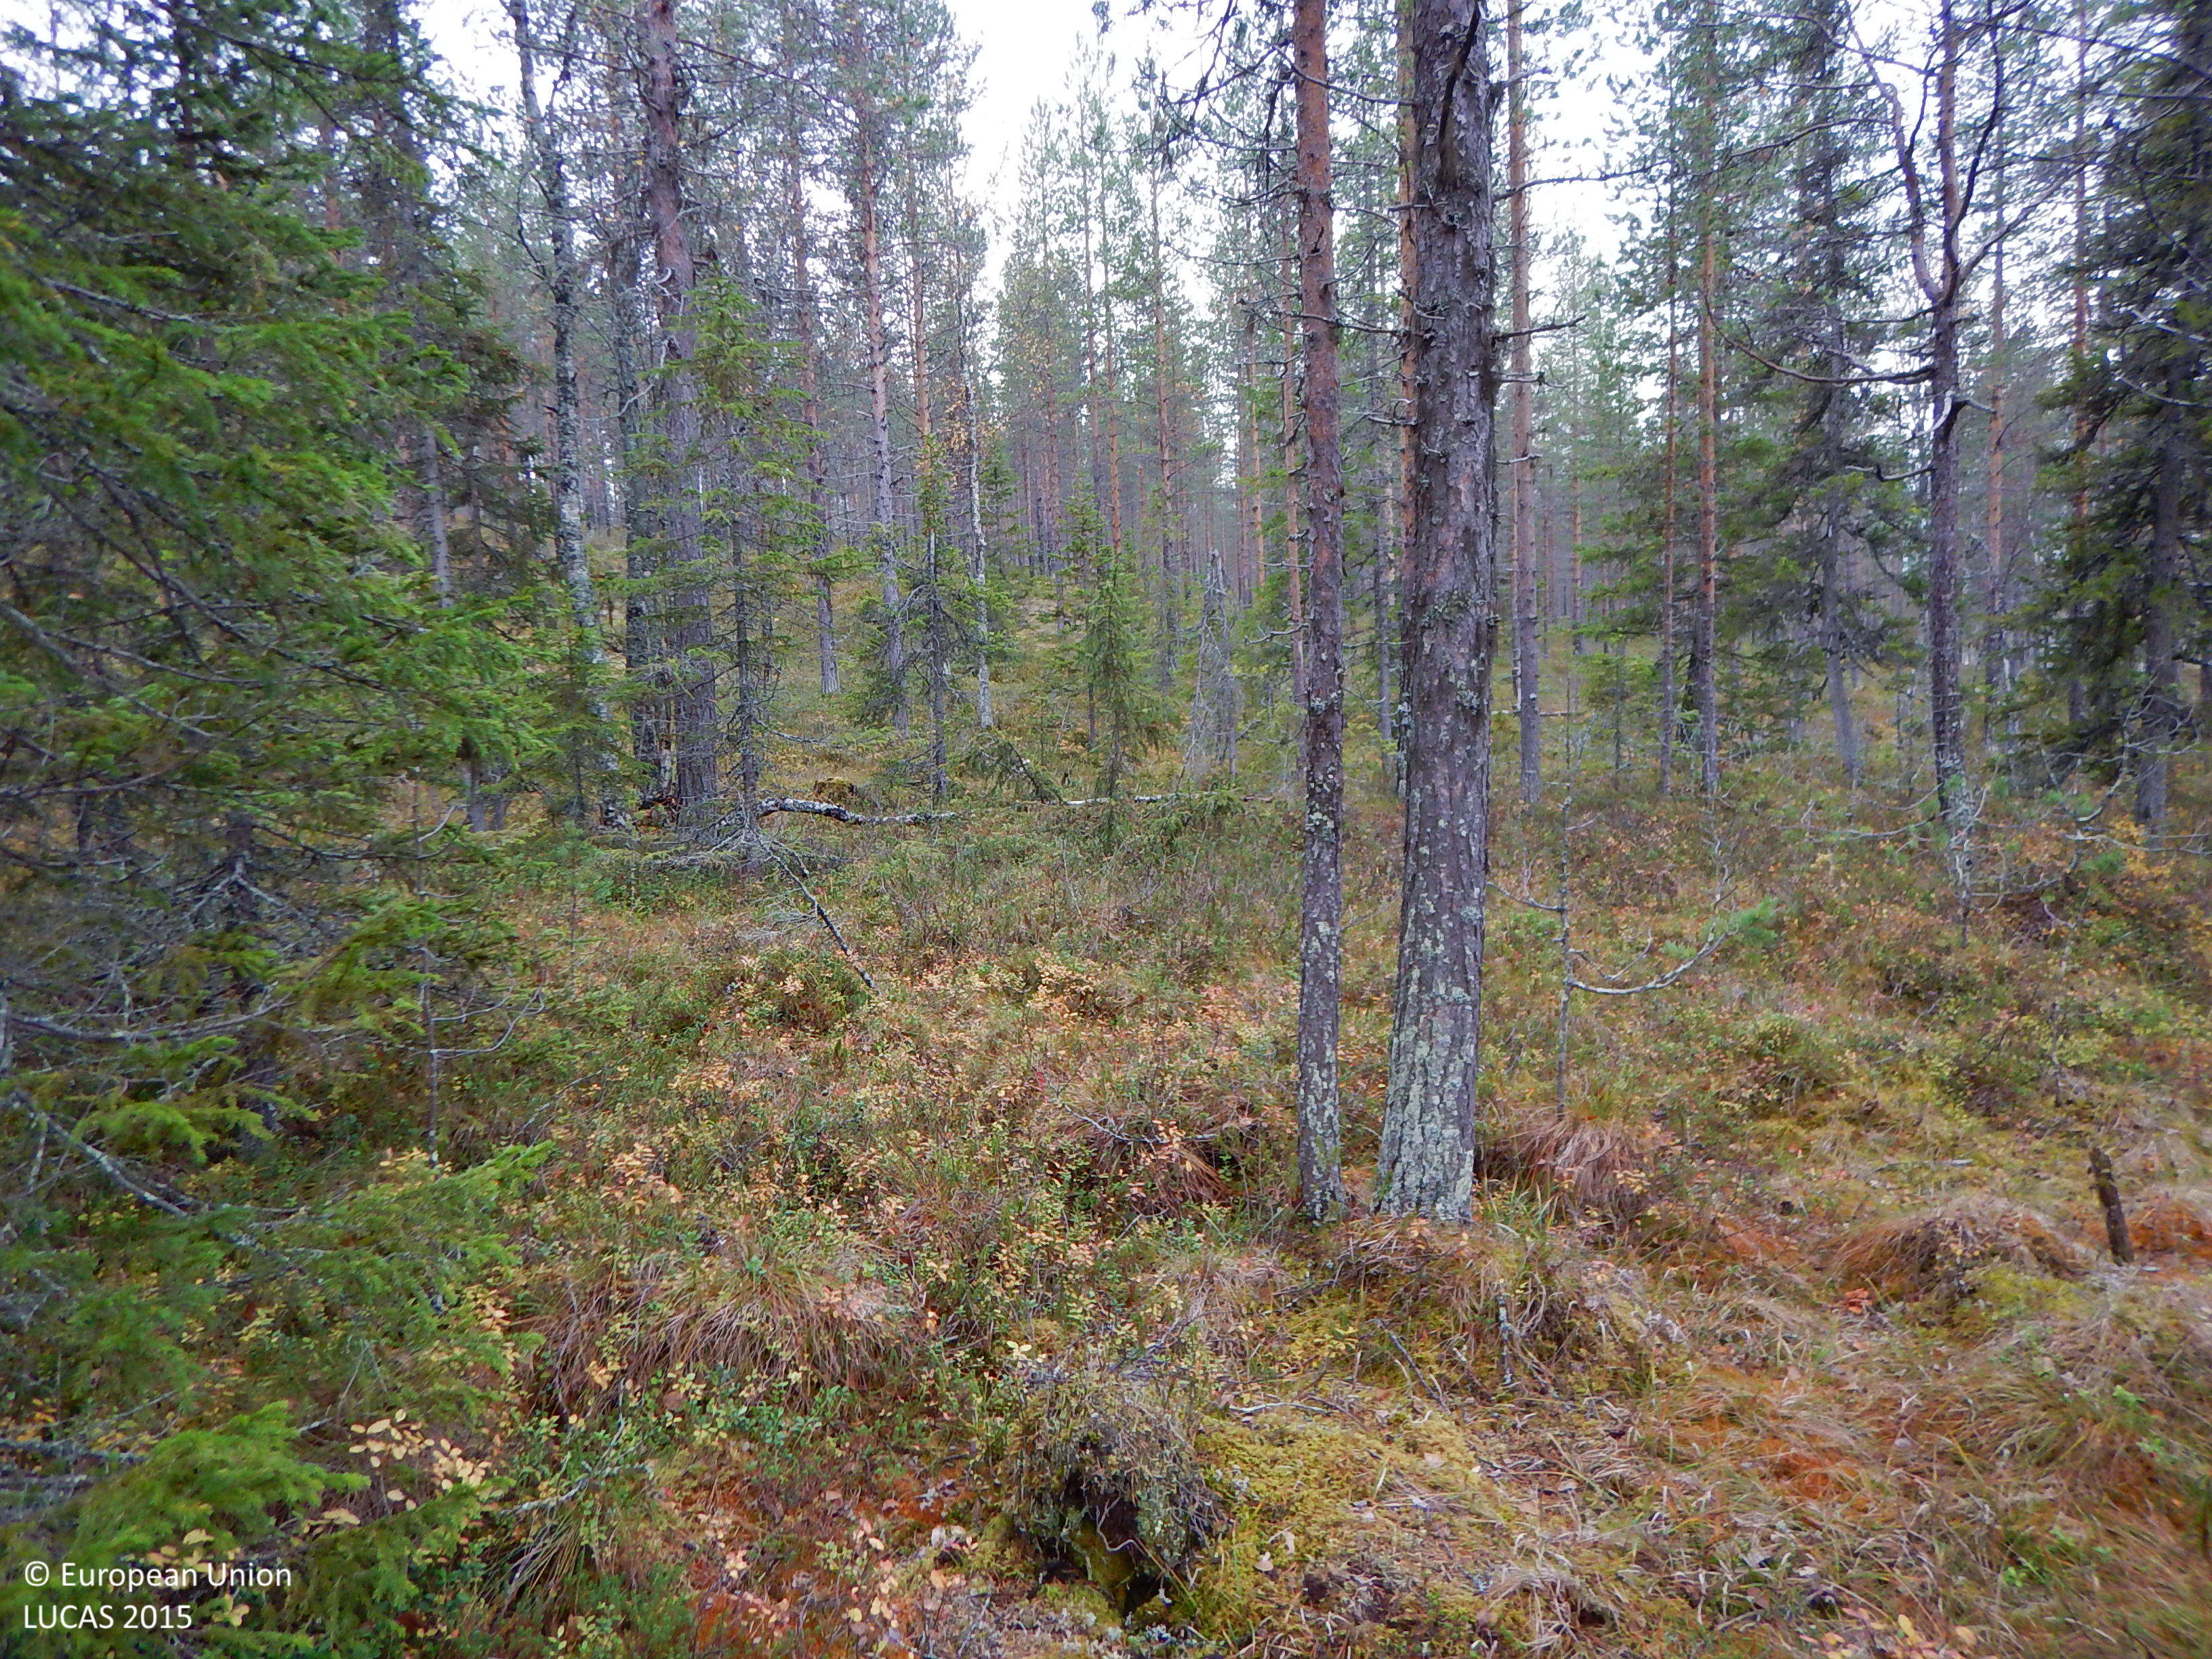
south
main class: Woodland
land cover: Pine dominated coniferous woodland
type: boreal forest
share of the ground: 50 - 75 %
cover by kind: coniferous forest trees 55 %, shrubs 20 %, lichens and mosses 20 %, herbaceous plants 5 %
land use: Forestry
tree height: > 5 m
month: September
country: SE
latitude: 65.0945
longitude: 19.2228
